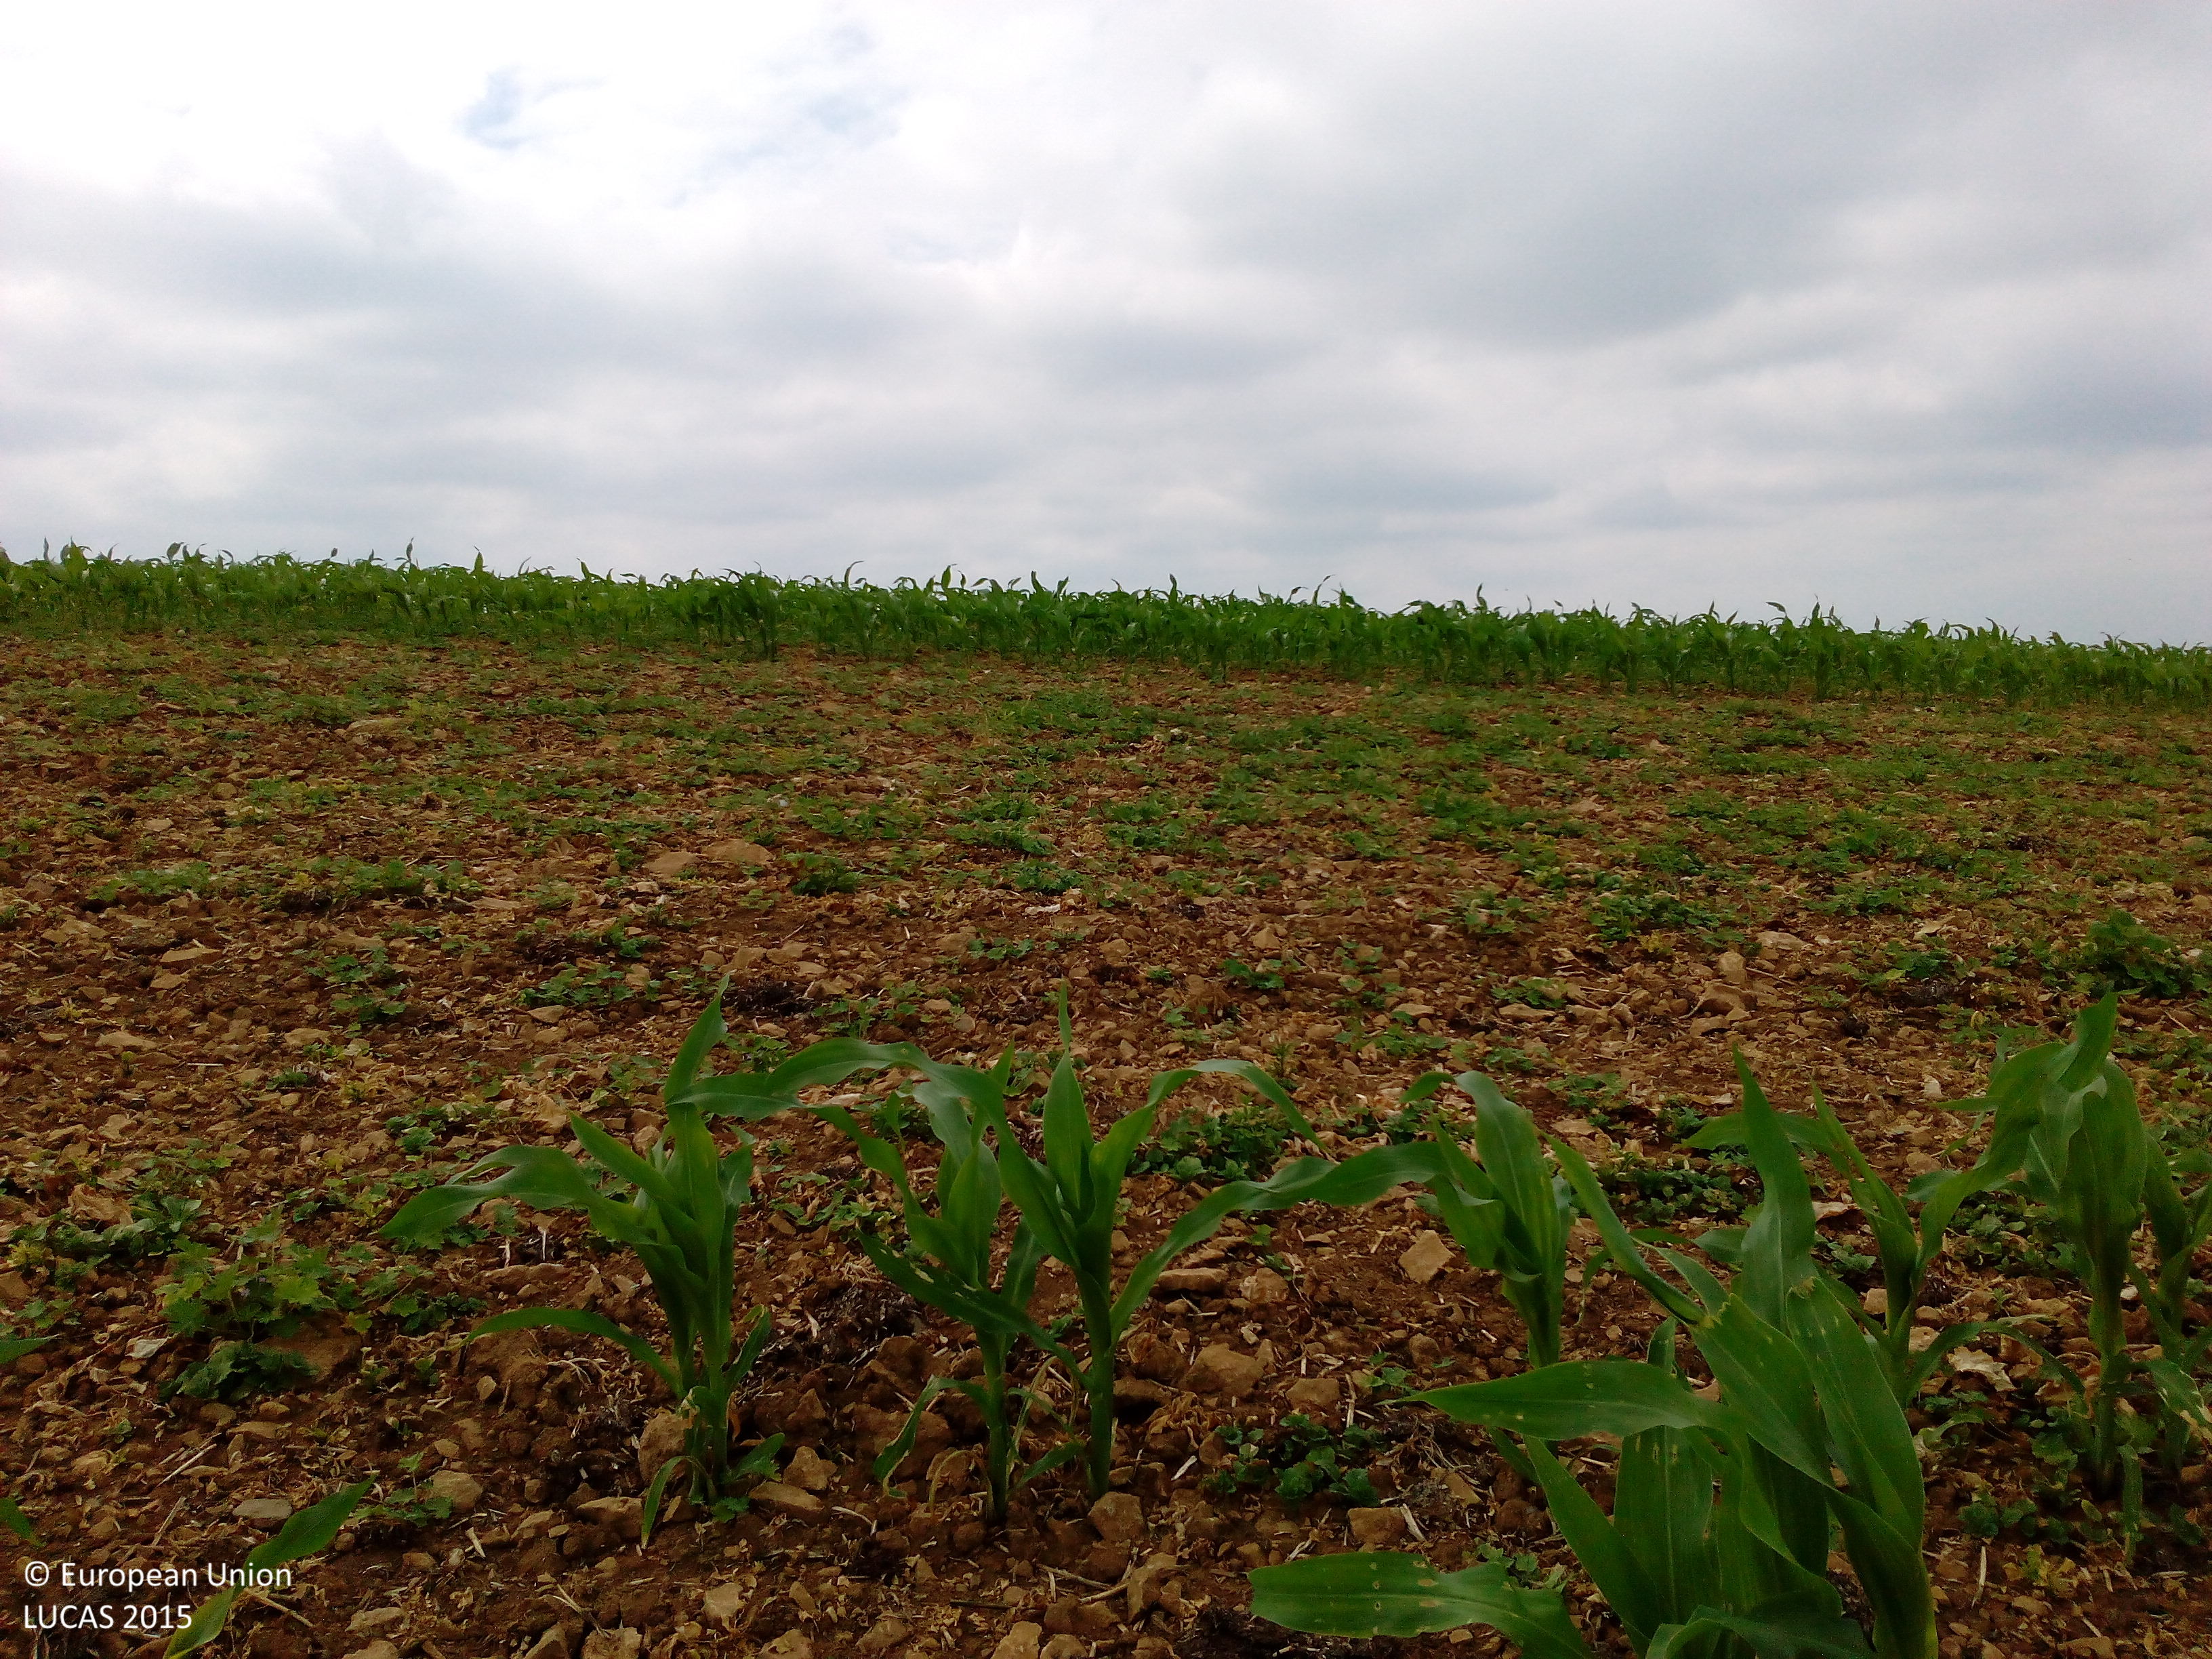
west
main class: Cropland
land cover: Maize
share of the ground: 25 - 50 %
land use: Agriculture (excluding fallow land and kitchen gardens)
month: June
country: DE
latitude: 50.6414
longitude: 11.5410
